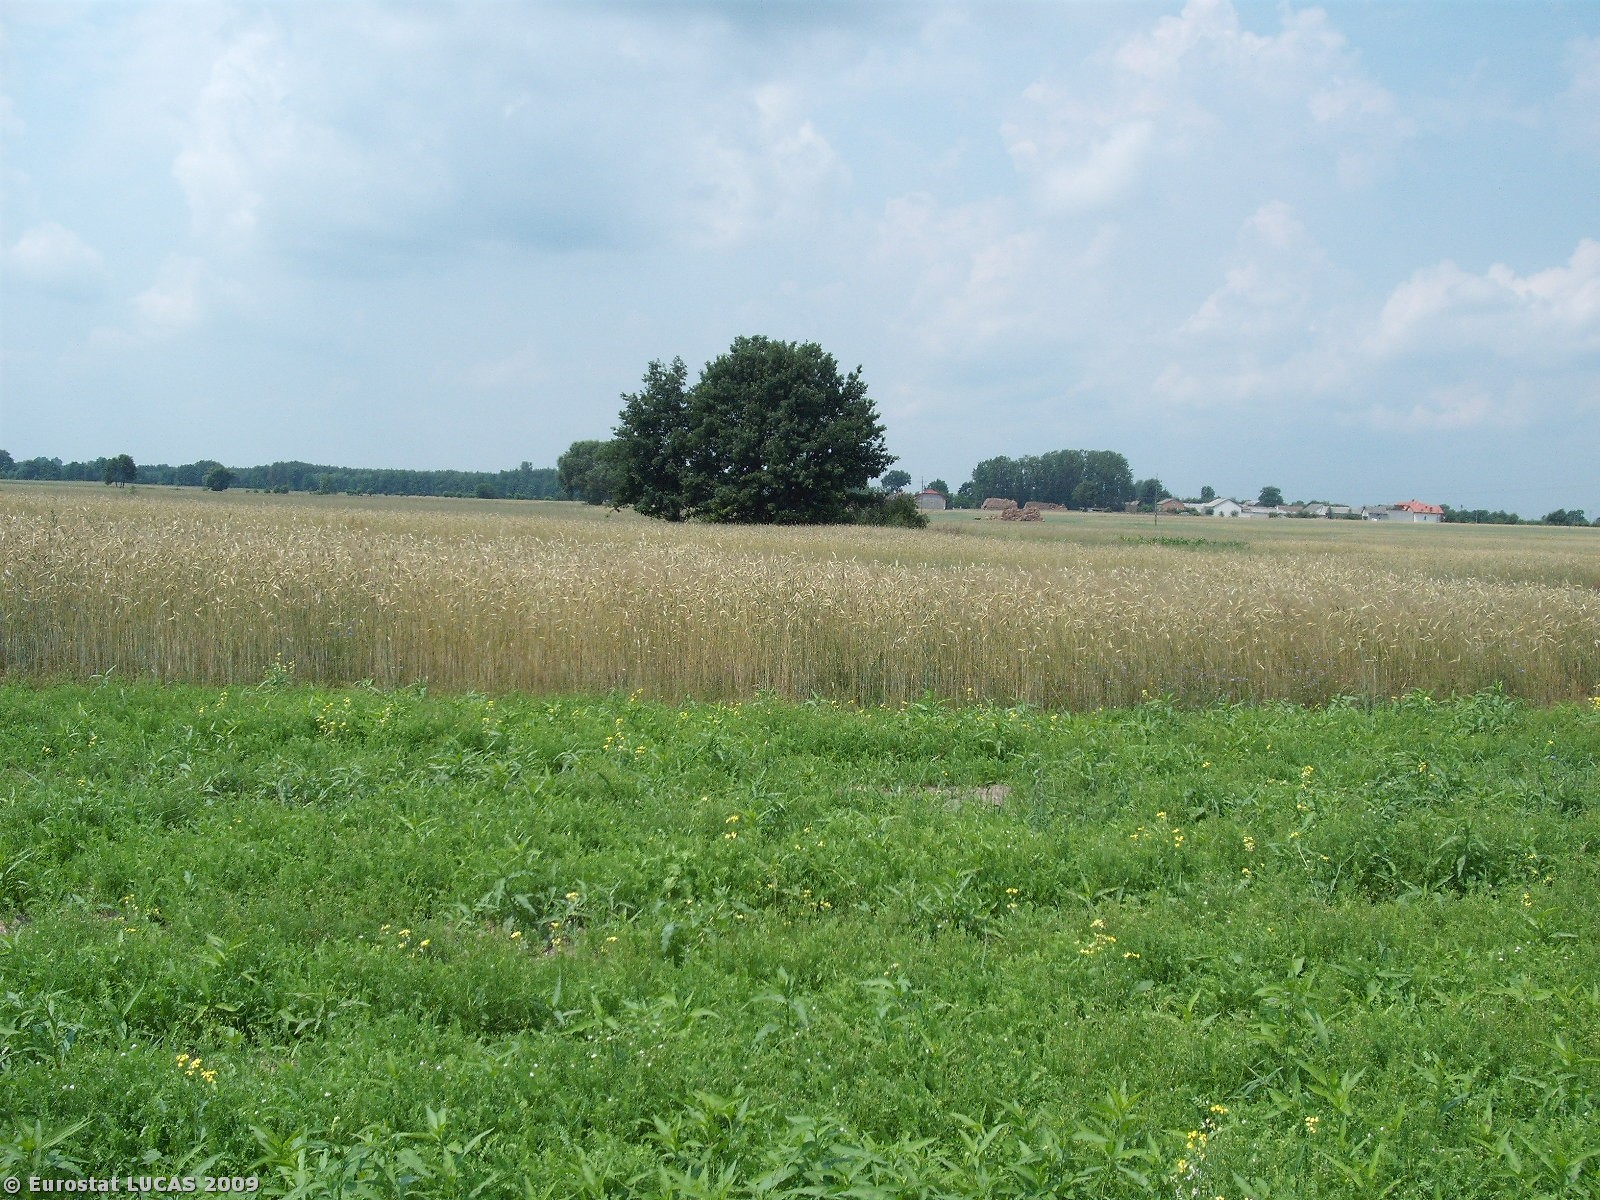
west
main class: Grassland
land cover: Spontaneously vegetated surfaces
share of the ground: > 75 %
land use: Fallow land
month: July
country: PL
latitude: 51.4492
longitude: 20.5869
